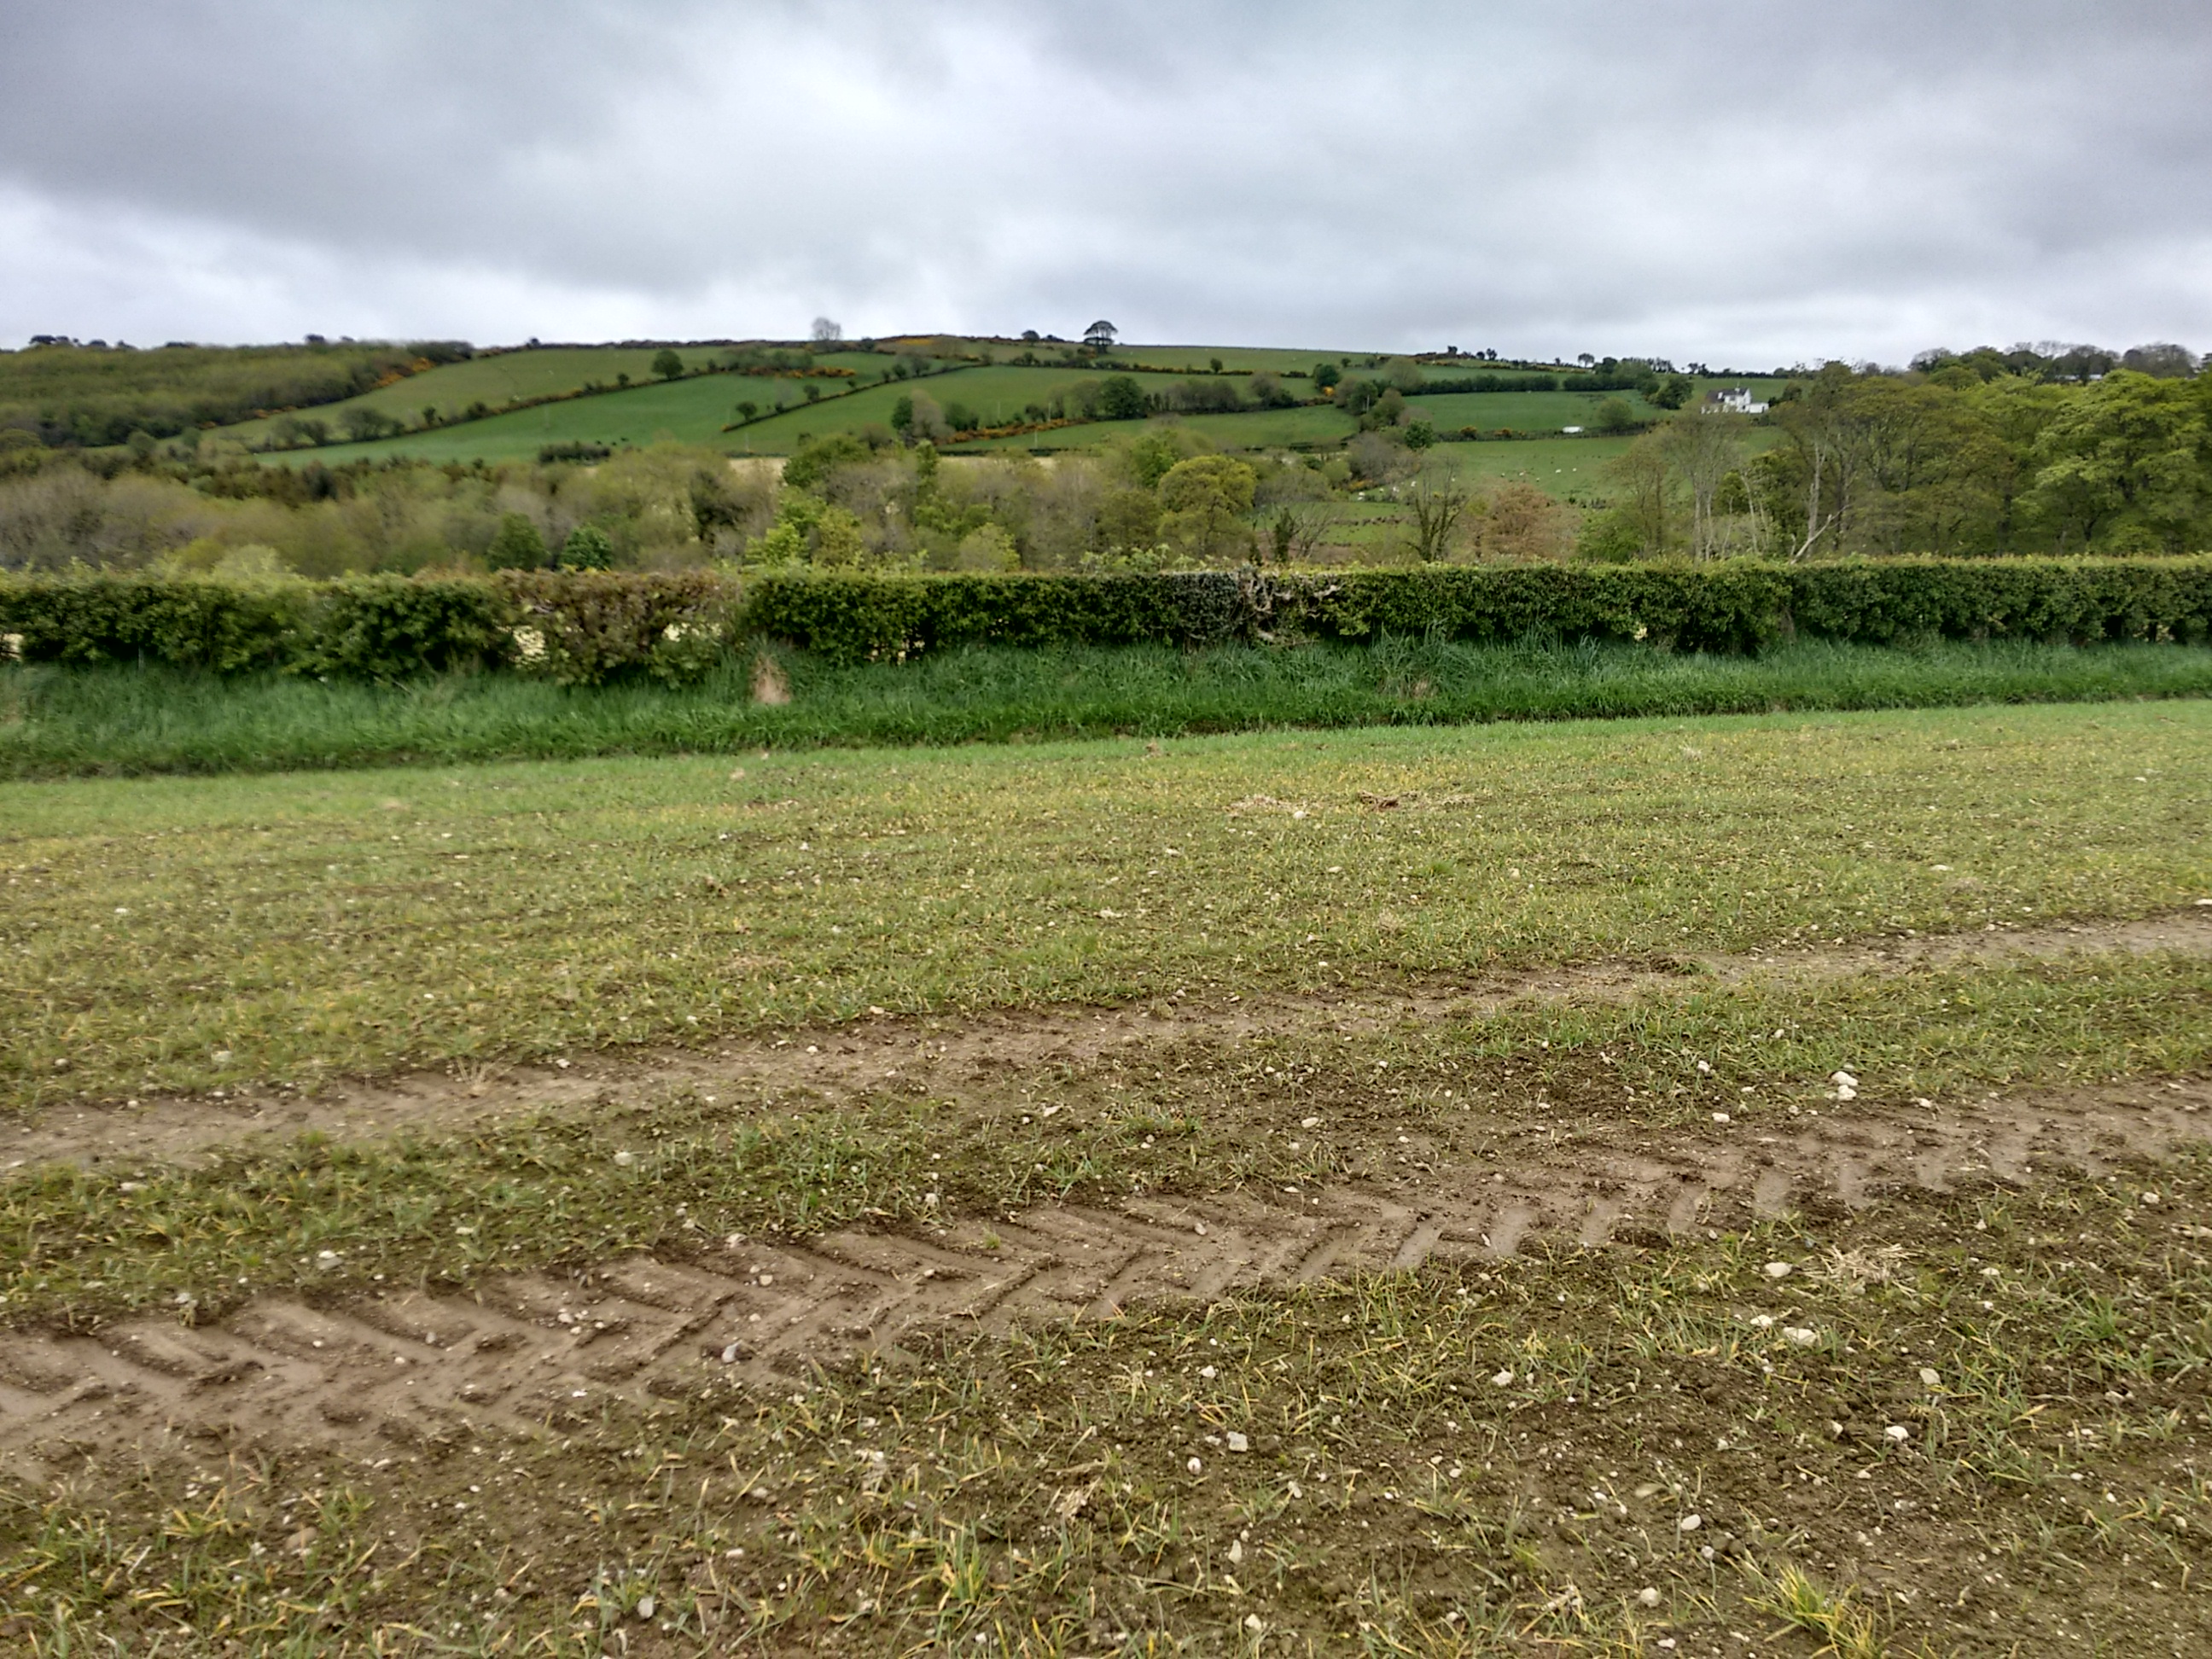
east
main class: Cropland
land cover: Barley
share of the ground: > 75 %
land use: Agriculture (excluding fallow land and kitchen gardens)
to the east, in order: Barley; Grass margins; Managed hedges; Grass margins; Grassland without tree/shrub cover; Broadleaved woodland; Rivers and streams; Broadleaved woodland; Fences; Grass margins; Barley
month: May
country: GB
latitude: 55.0162
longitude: -7.1746
